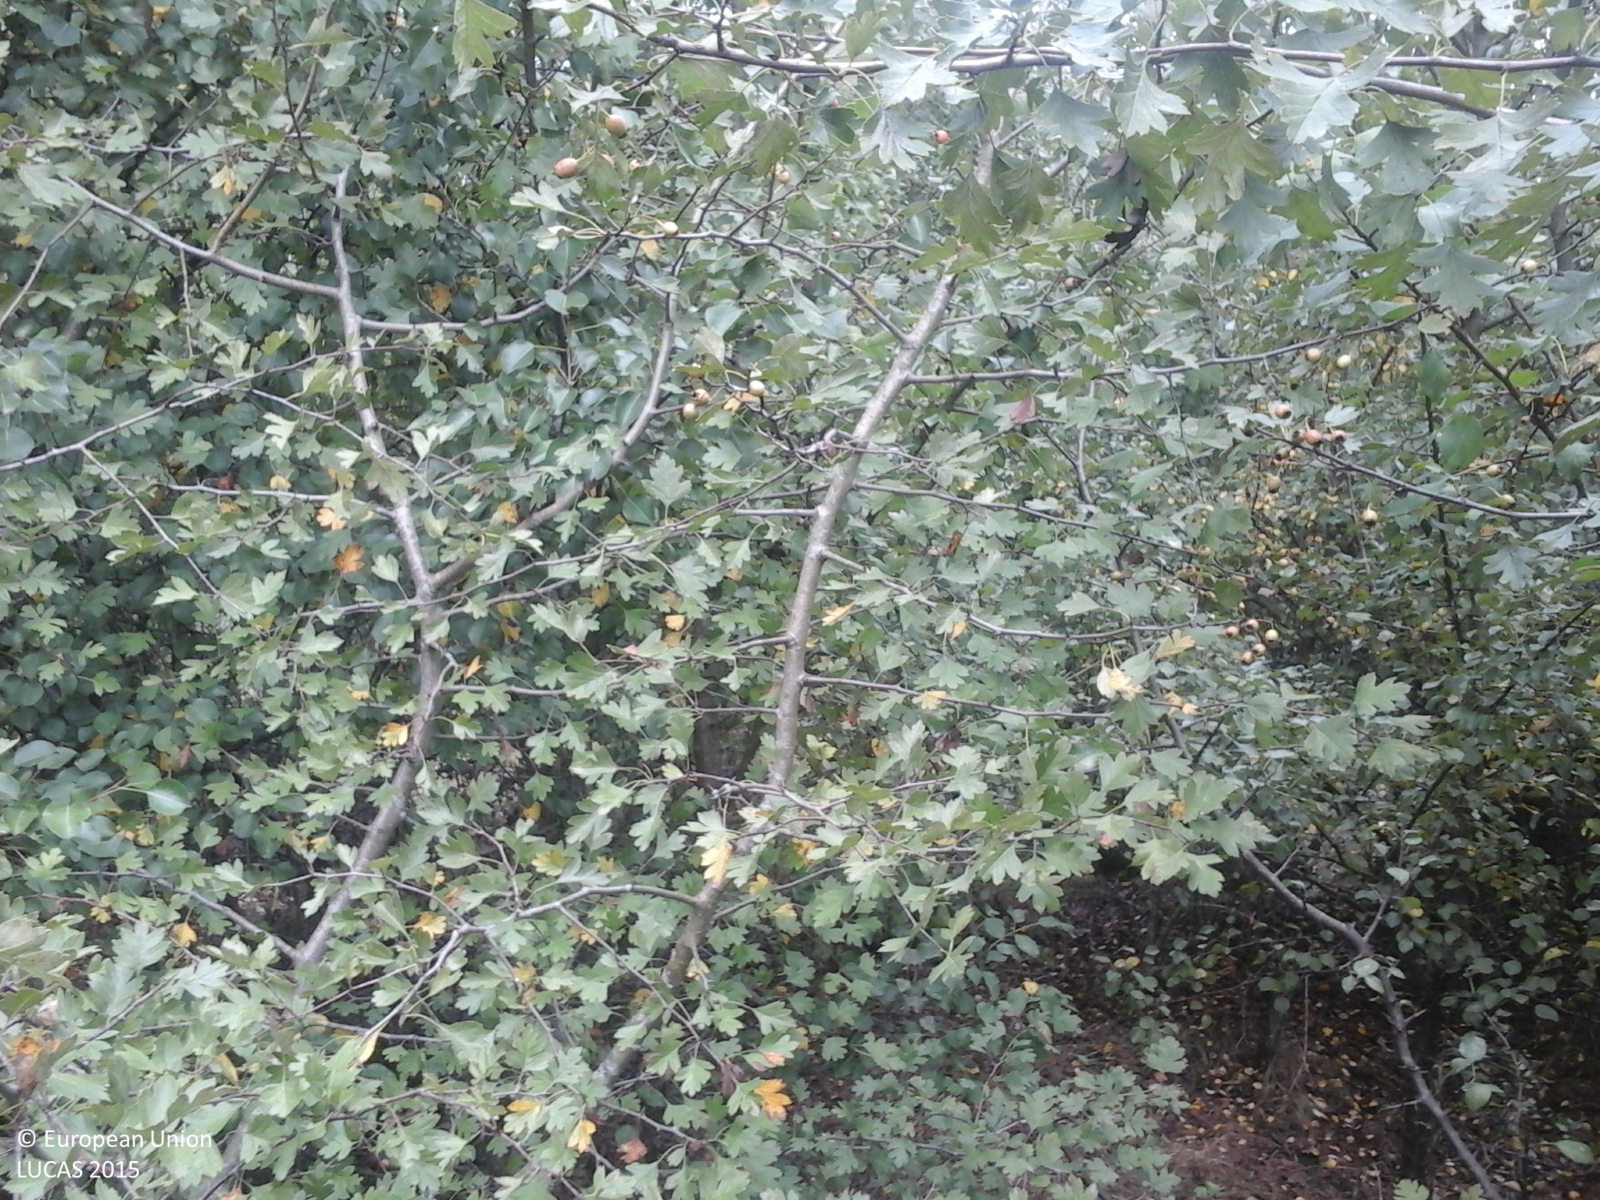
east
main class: Shrubland
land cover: Shrubland with sparse tree cover
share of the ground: > 75 %
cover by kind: herbaceous plants 70 %, shrubs 25 %, broadleaved forest trees 5 %
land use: Semi-natural and natural areas not in use
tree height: < 5 m
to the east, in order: Shrubland with sparse tree cover; Broadleaved woodland; Grassland without tree/shrub cover; Tracks; Grassland without tree/shrub cover; Grassland with sparse tree/shrub cover; Tracks; Broadleaved woodland
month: August
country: RO
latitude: 45.9121
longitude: 21.6522
